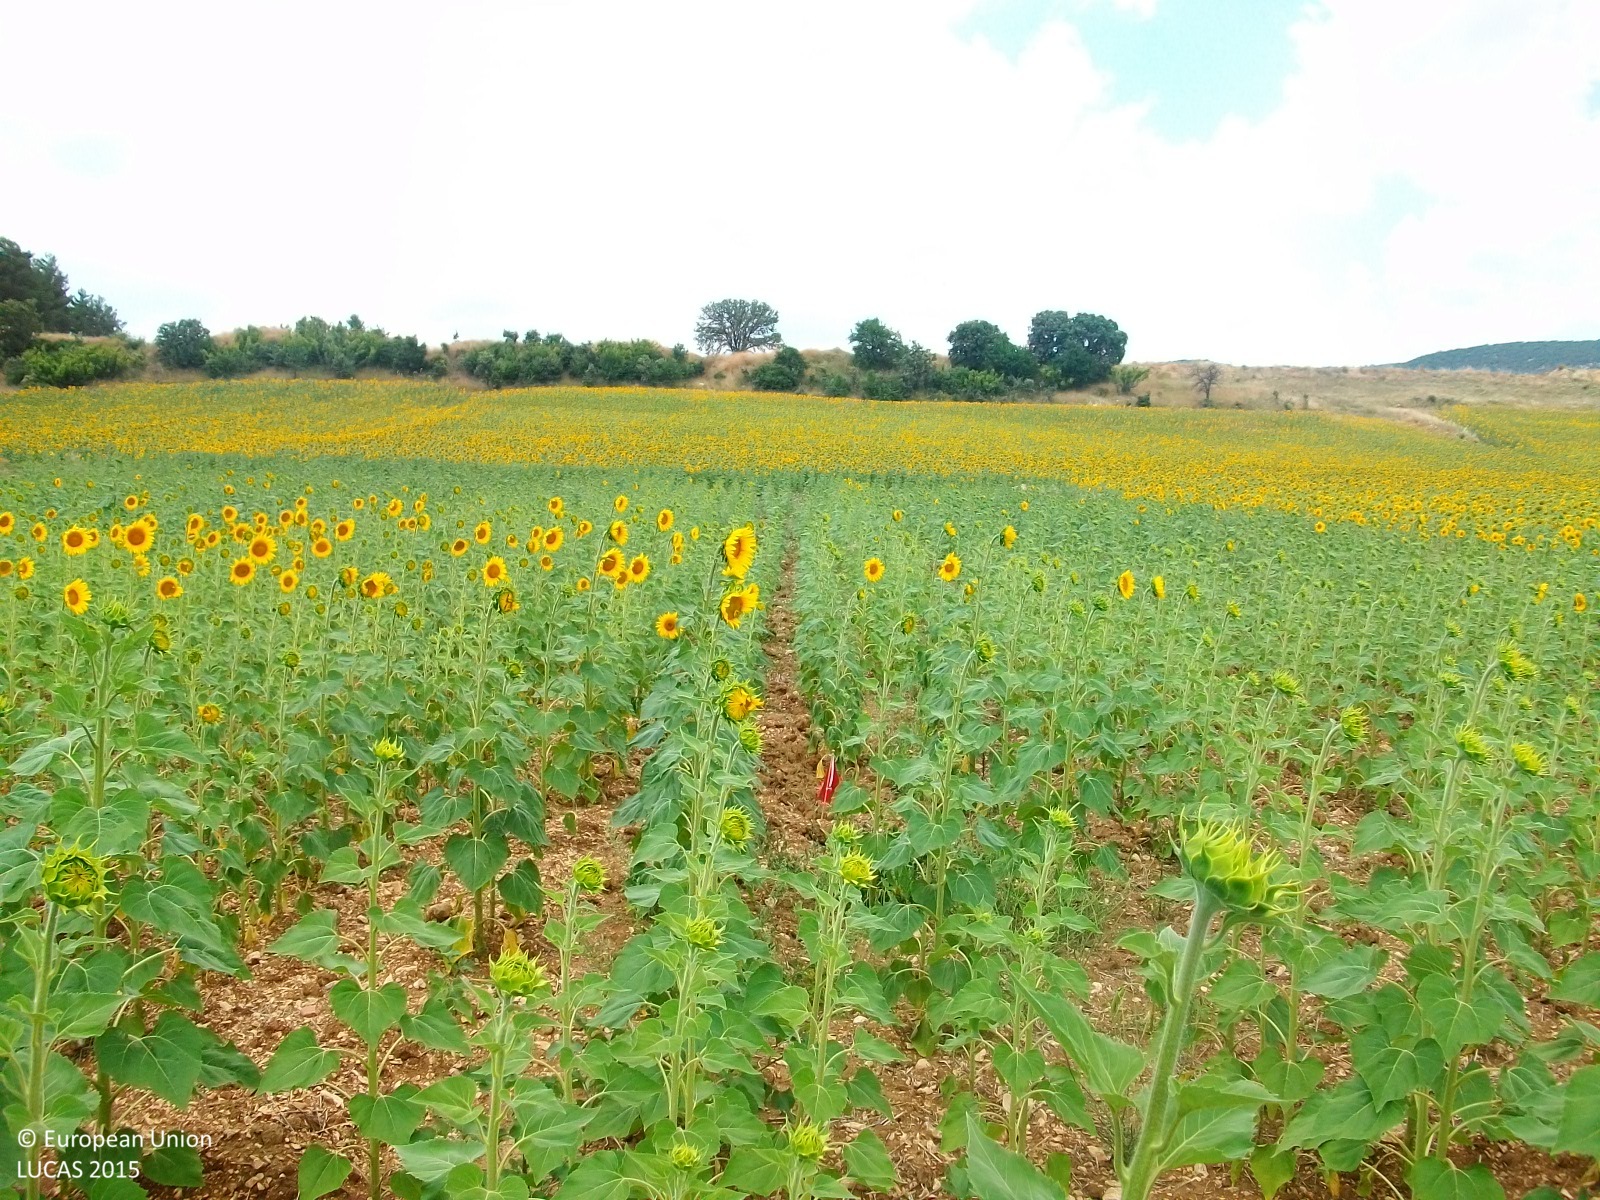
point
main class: Cropland
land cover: Sunflower
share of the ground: > 75 %
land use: Agriculture (excluding fallow land and kitchen gardens)
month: July
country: GR
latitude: 40.9236
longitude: 25.9349
